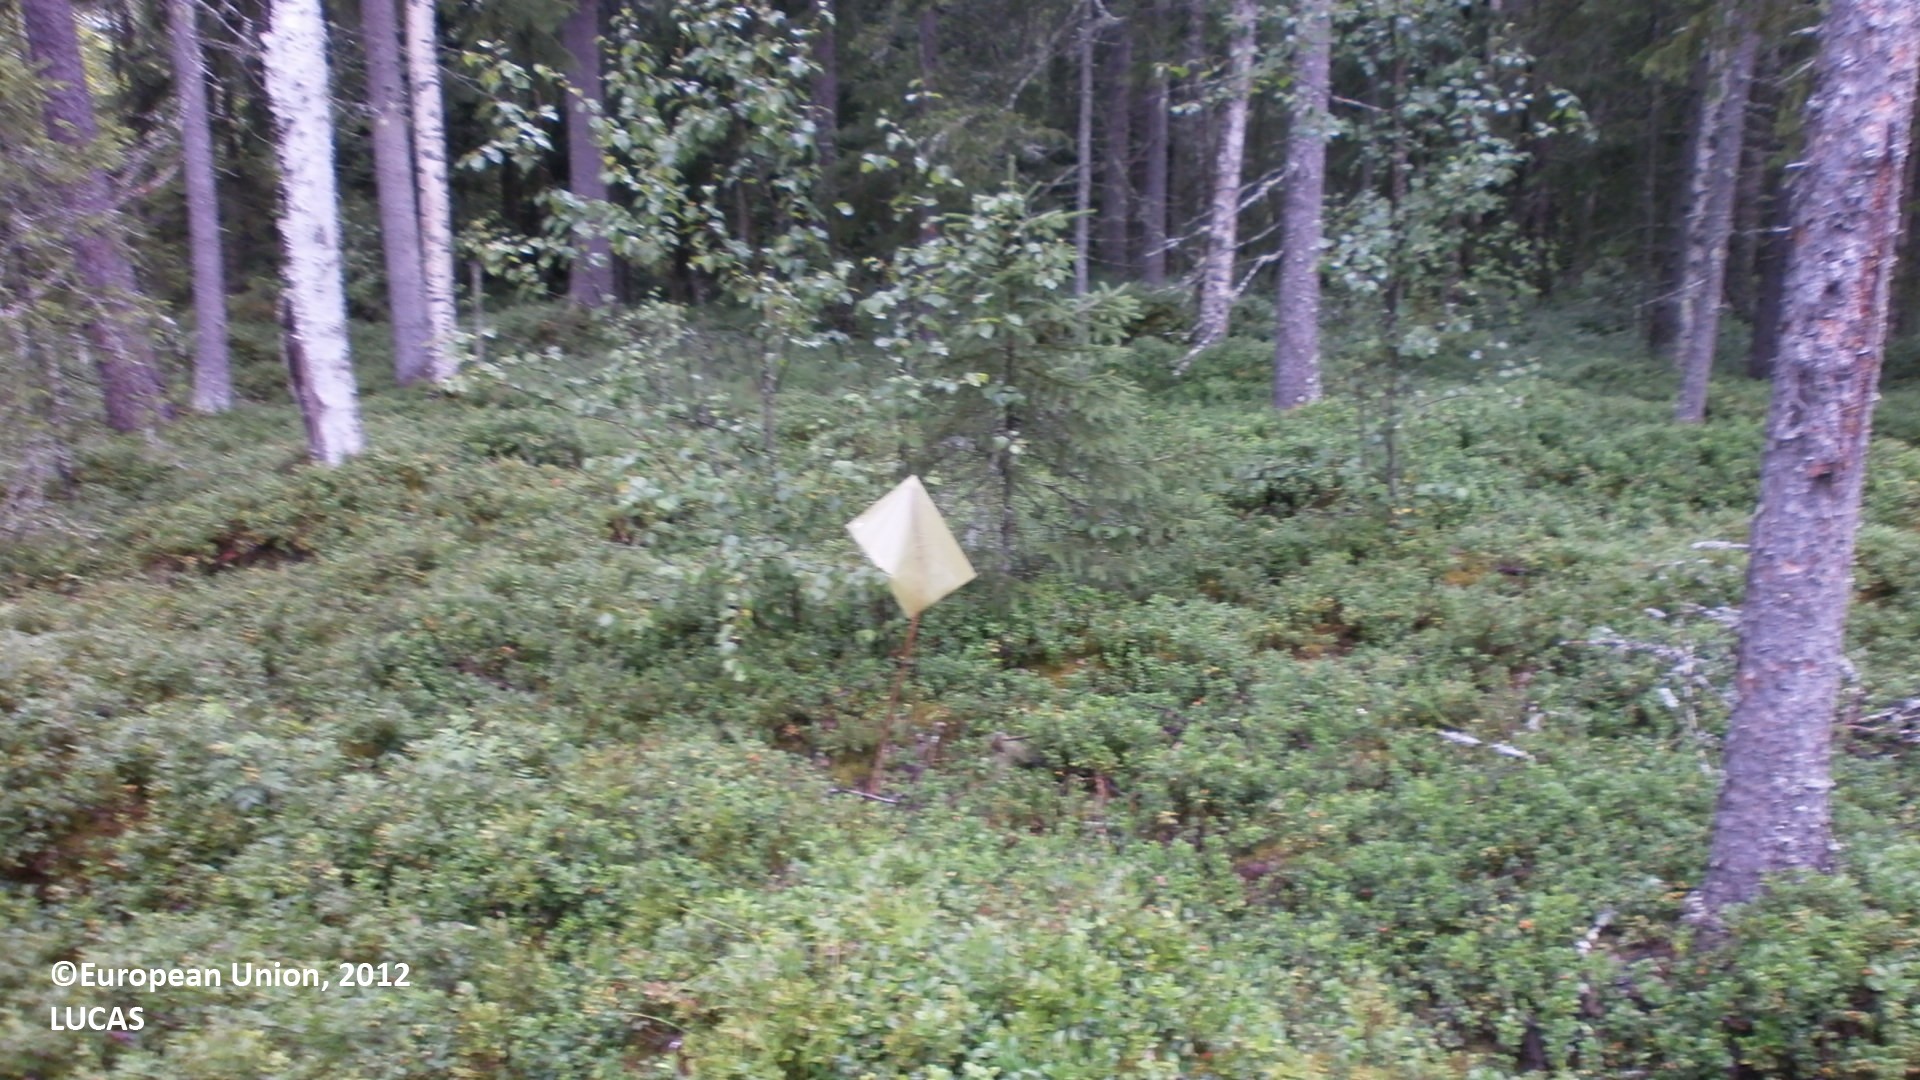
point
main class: Woodland
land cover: Spruce dominated mixed woodland
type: boreal forest
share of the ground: > 75 %
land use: Forestry
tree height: > 5 m
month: July
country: FI
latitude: 64.0522
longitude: 23.7646
